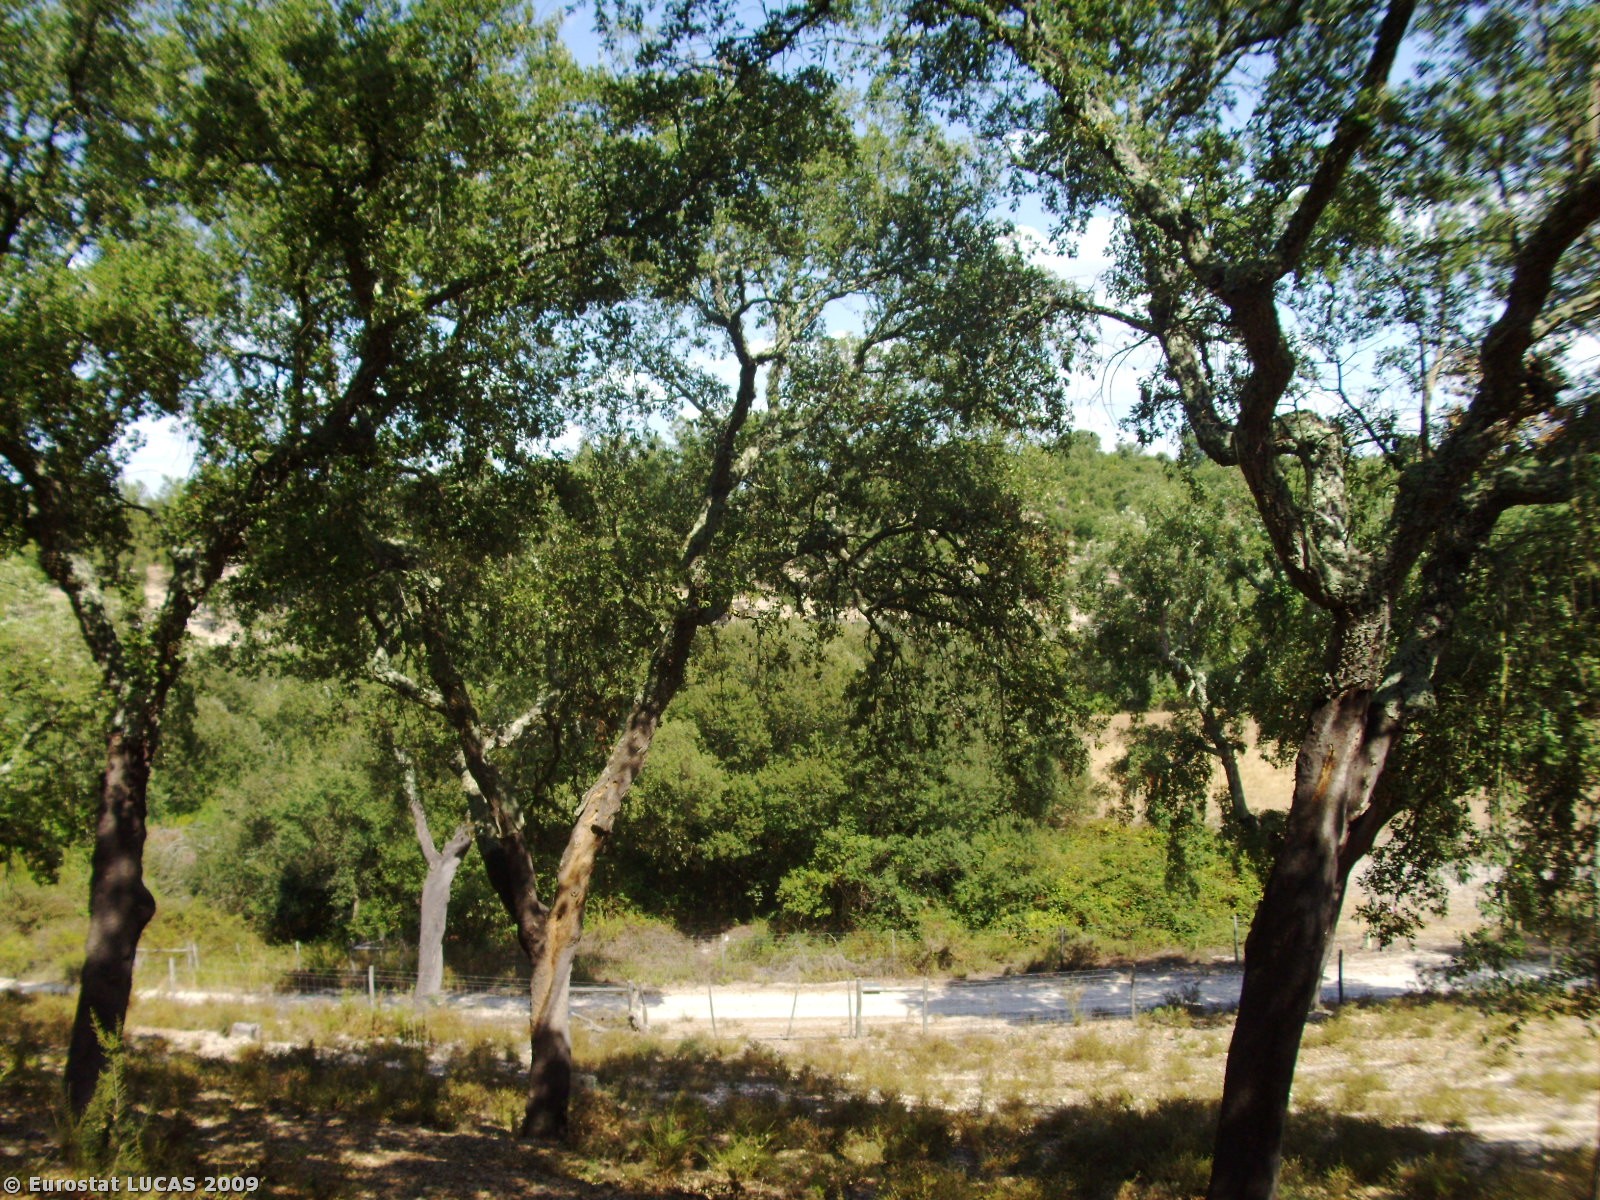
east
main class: Woodland
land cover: Broadleaved woodland
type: broadleaved evergreen forest
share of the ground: > 75 %
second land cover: Spontaneously vegetated surfaces
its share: 10 - 25 %
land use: Forestry
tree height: > 5 m
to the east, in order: Broadleaved woodland; Spontaneously vegetated surfaces; Broadleaved woodland; Spontaneously vegetated surfaces; Fences; Tracks; Fences; Shrubland with sparse tree cover; Fences; Spontaneously vegetated surfaces; Shruby margins; Rivers and streams; Shruby margins; Spontaneously vegetated surfaces; Lines of trees; Spontaneously vegetated surfaces; Shrubland with sparse tree cover; Rivers and streams; Shruby margins; Fences; Shruby margins; Bare land; Mixed woodland; Broadleaved woodland
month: August
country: PT
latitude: 39.3132
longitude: -8.0692
